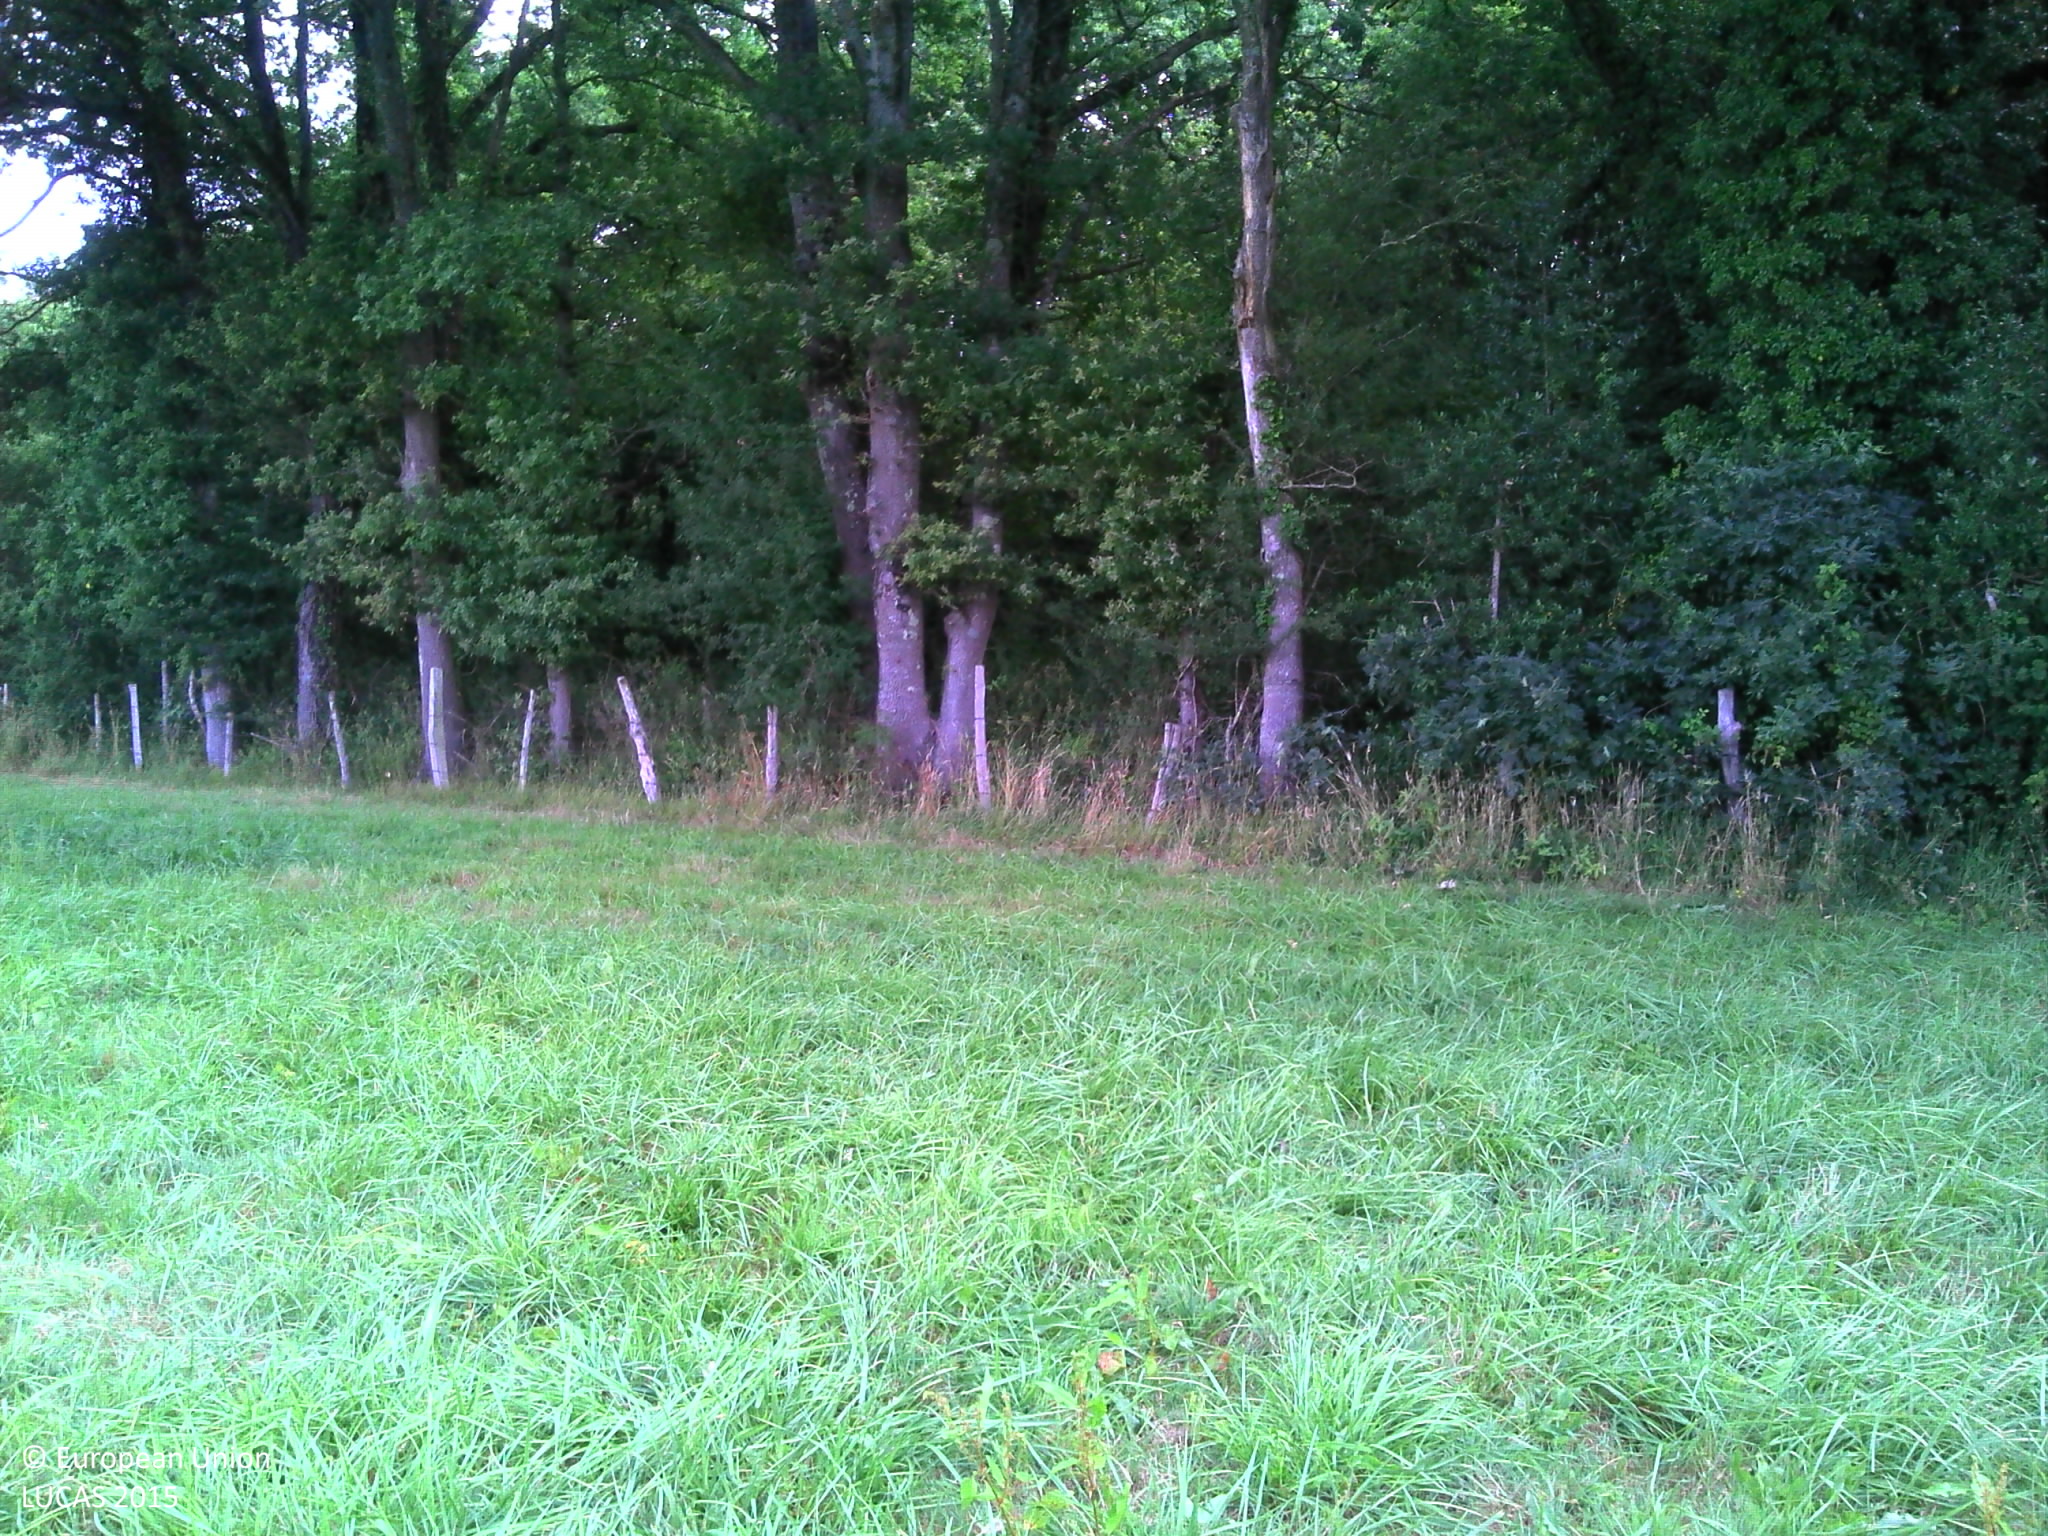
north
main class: Cropland
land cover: Temporary grasslands
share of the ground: > 75 %
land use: Agriculture (excluding fallow land and kitchen gardens)
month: July
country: FR
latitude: 47.3748
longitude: -1.5786
